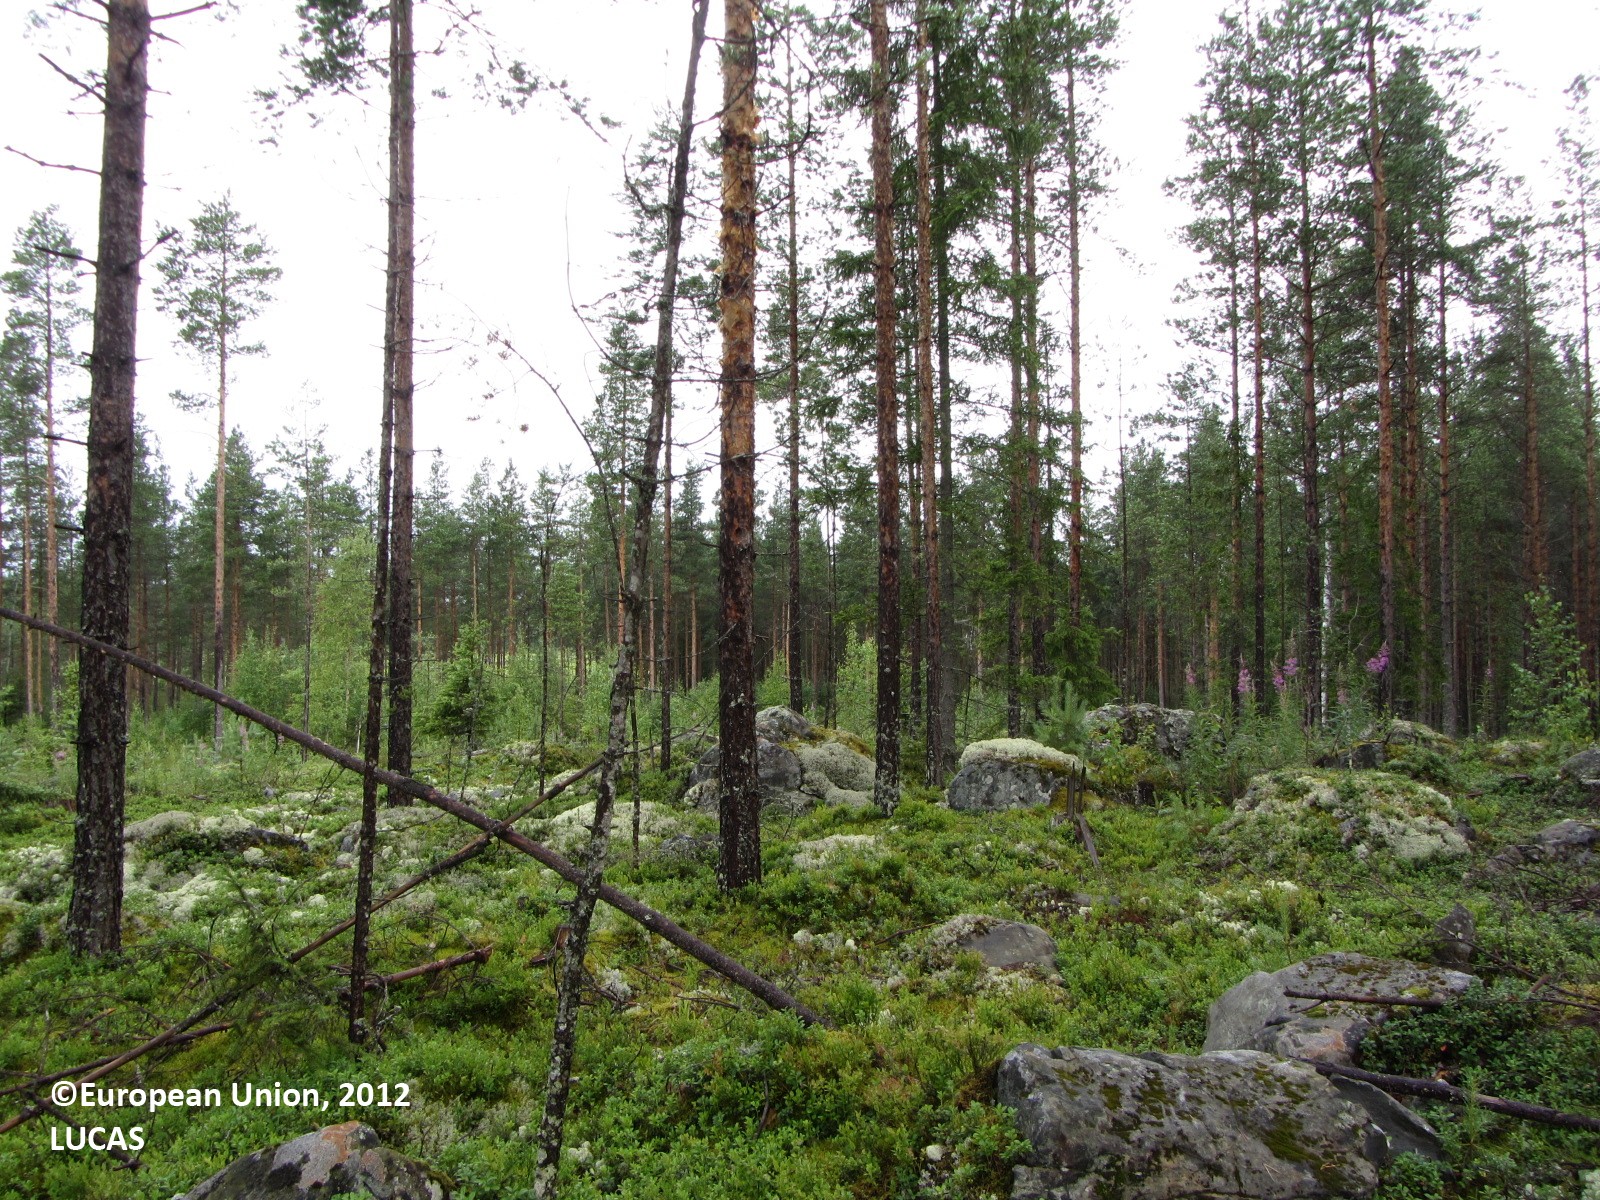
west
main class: Woodland
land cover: Pine dominated coniferous woodland
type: boreal forest
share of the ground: 50 - 75 %
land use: Forestry
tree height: > 5 m
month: July
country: FI
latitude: 63.9143
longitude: 24.8608
